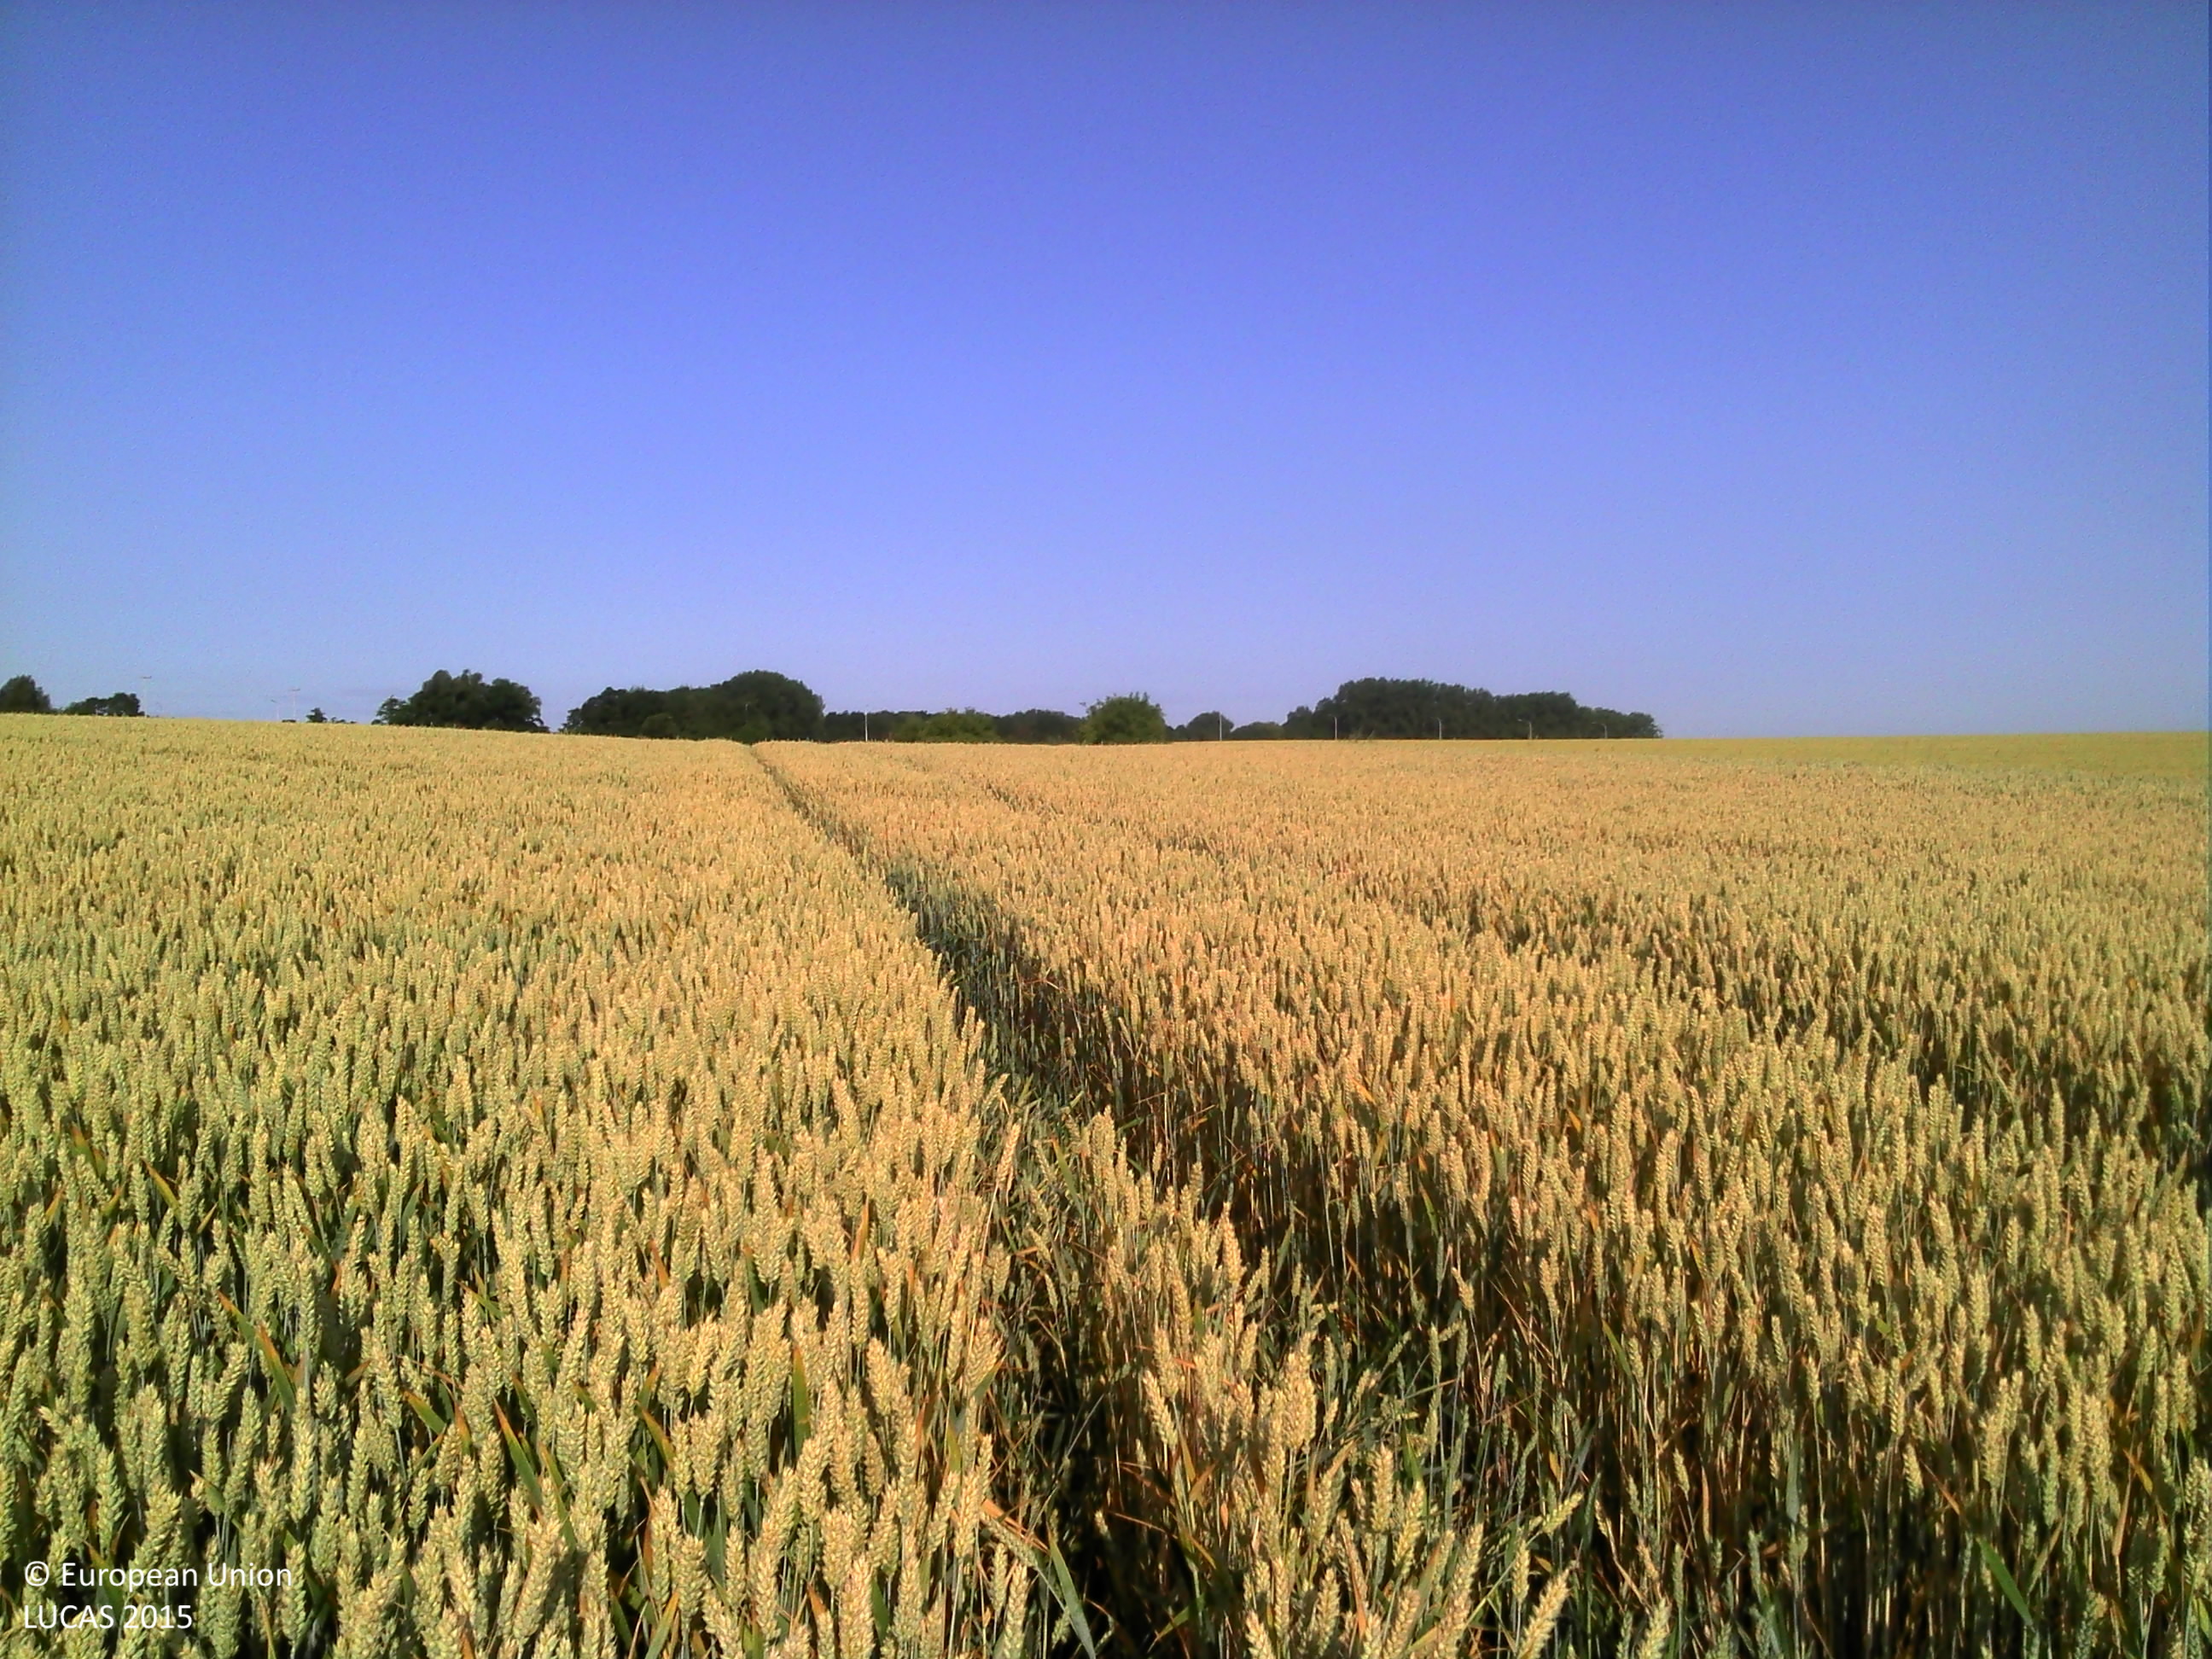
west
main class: Cropland
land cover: Common wheat
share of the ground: > 75 %
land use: Agriculture (excluding fallow land and kitchen gardens)
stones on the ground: < 10 %
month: July
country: BE
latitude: 50.7099
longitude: 5.1117
